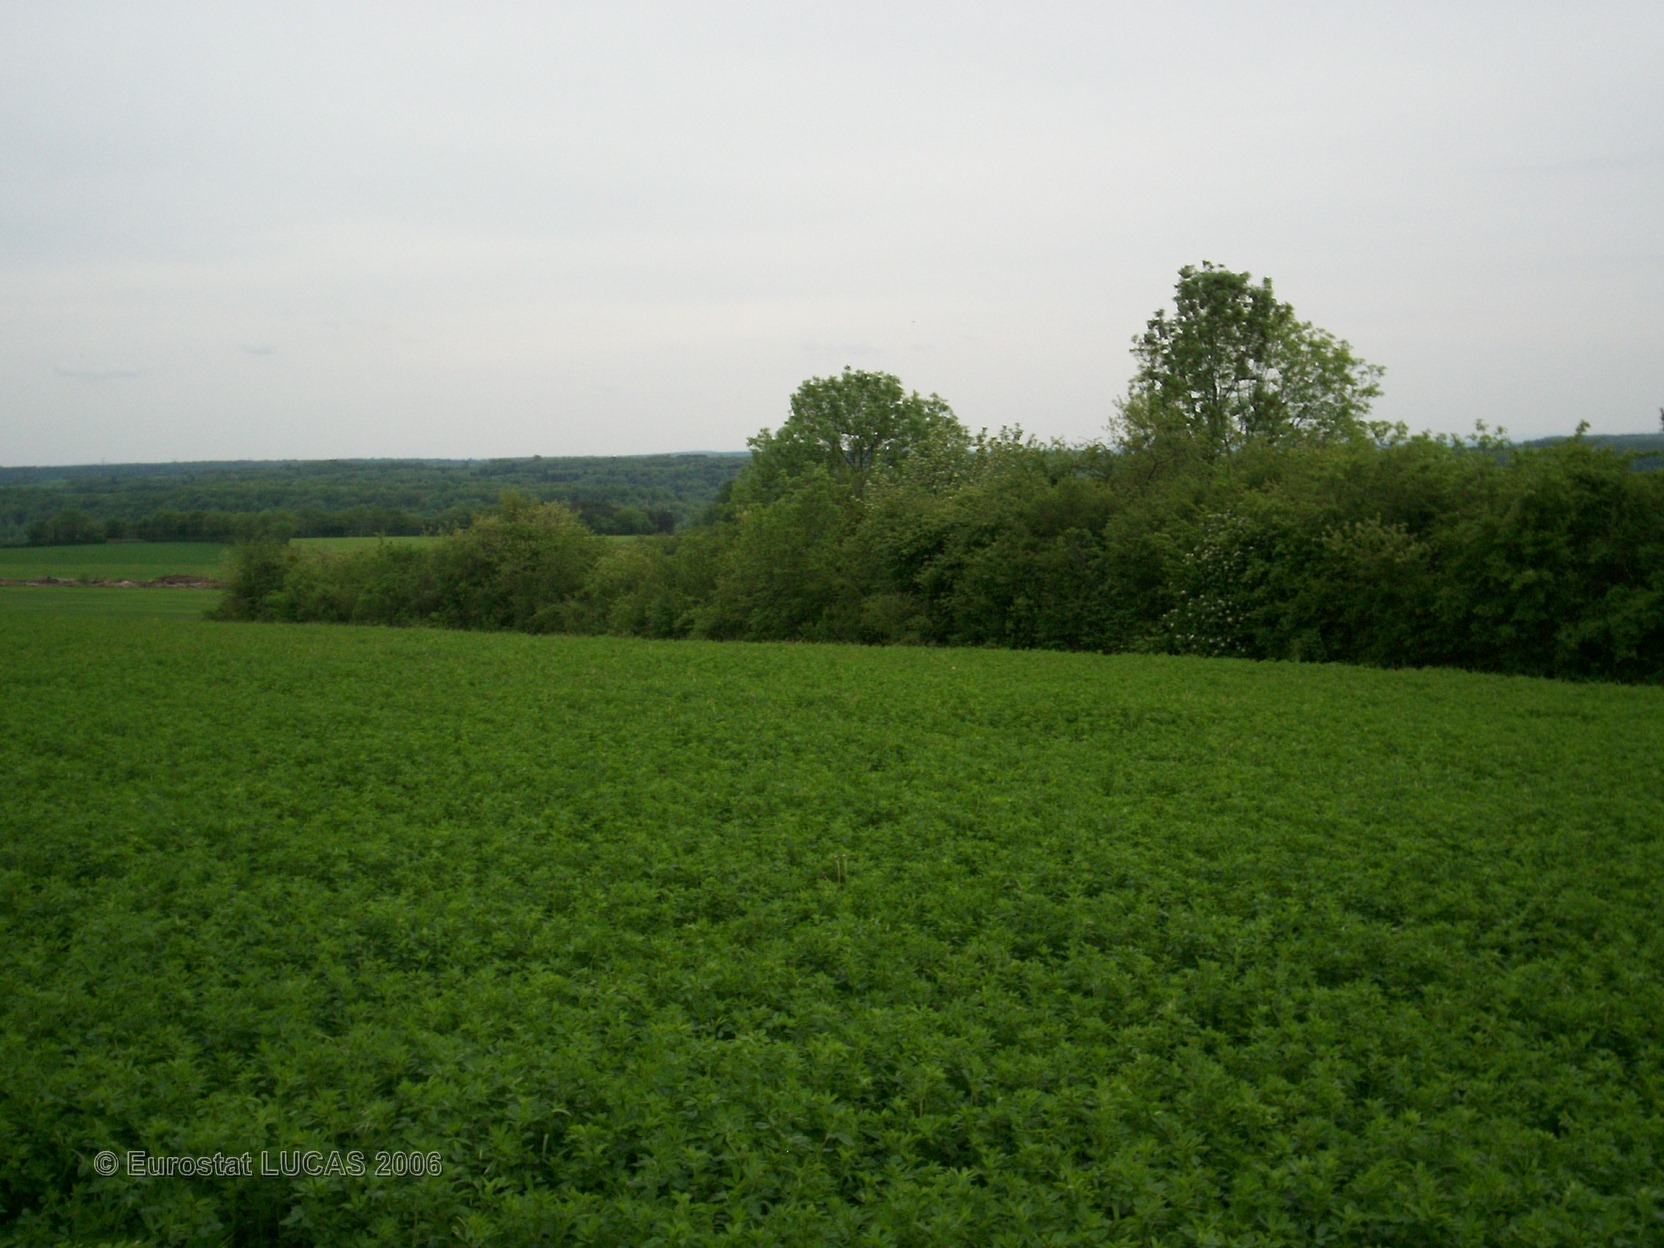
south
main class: Cropland
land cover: Lucerne
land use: Agriculture (excluding fallow land and kitchen gardens)
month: May
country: FR
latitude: 47.3190
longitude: 4.6682
